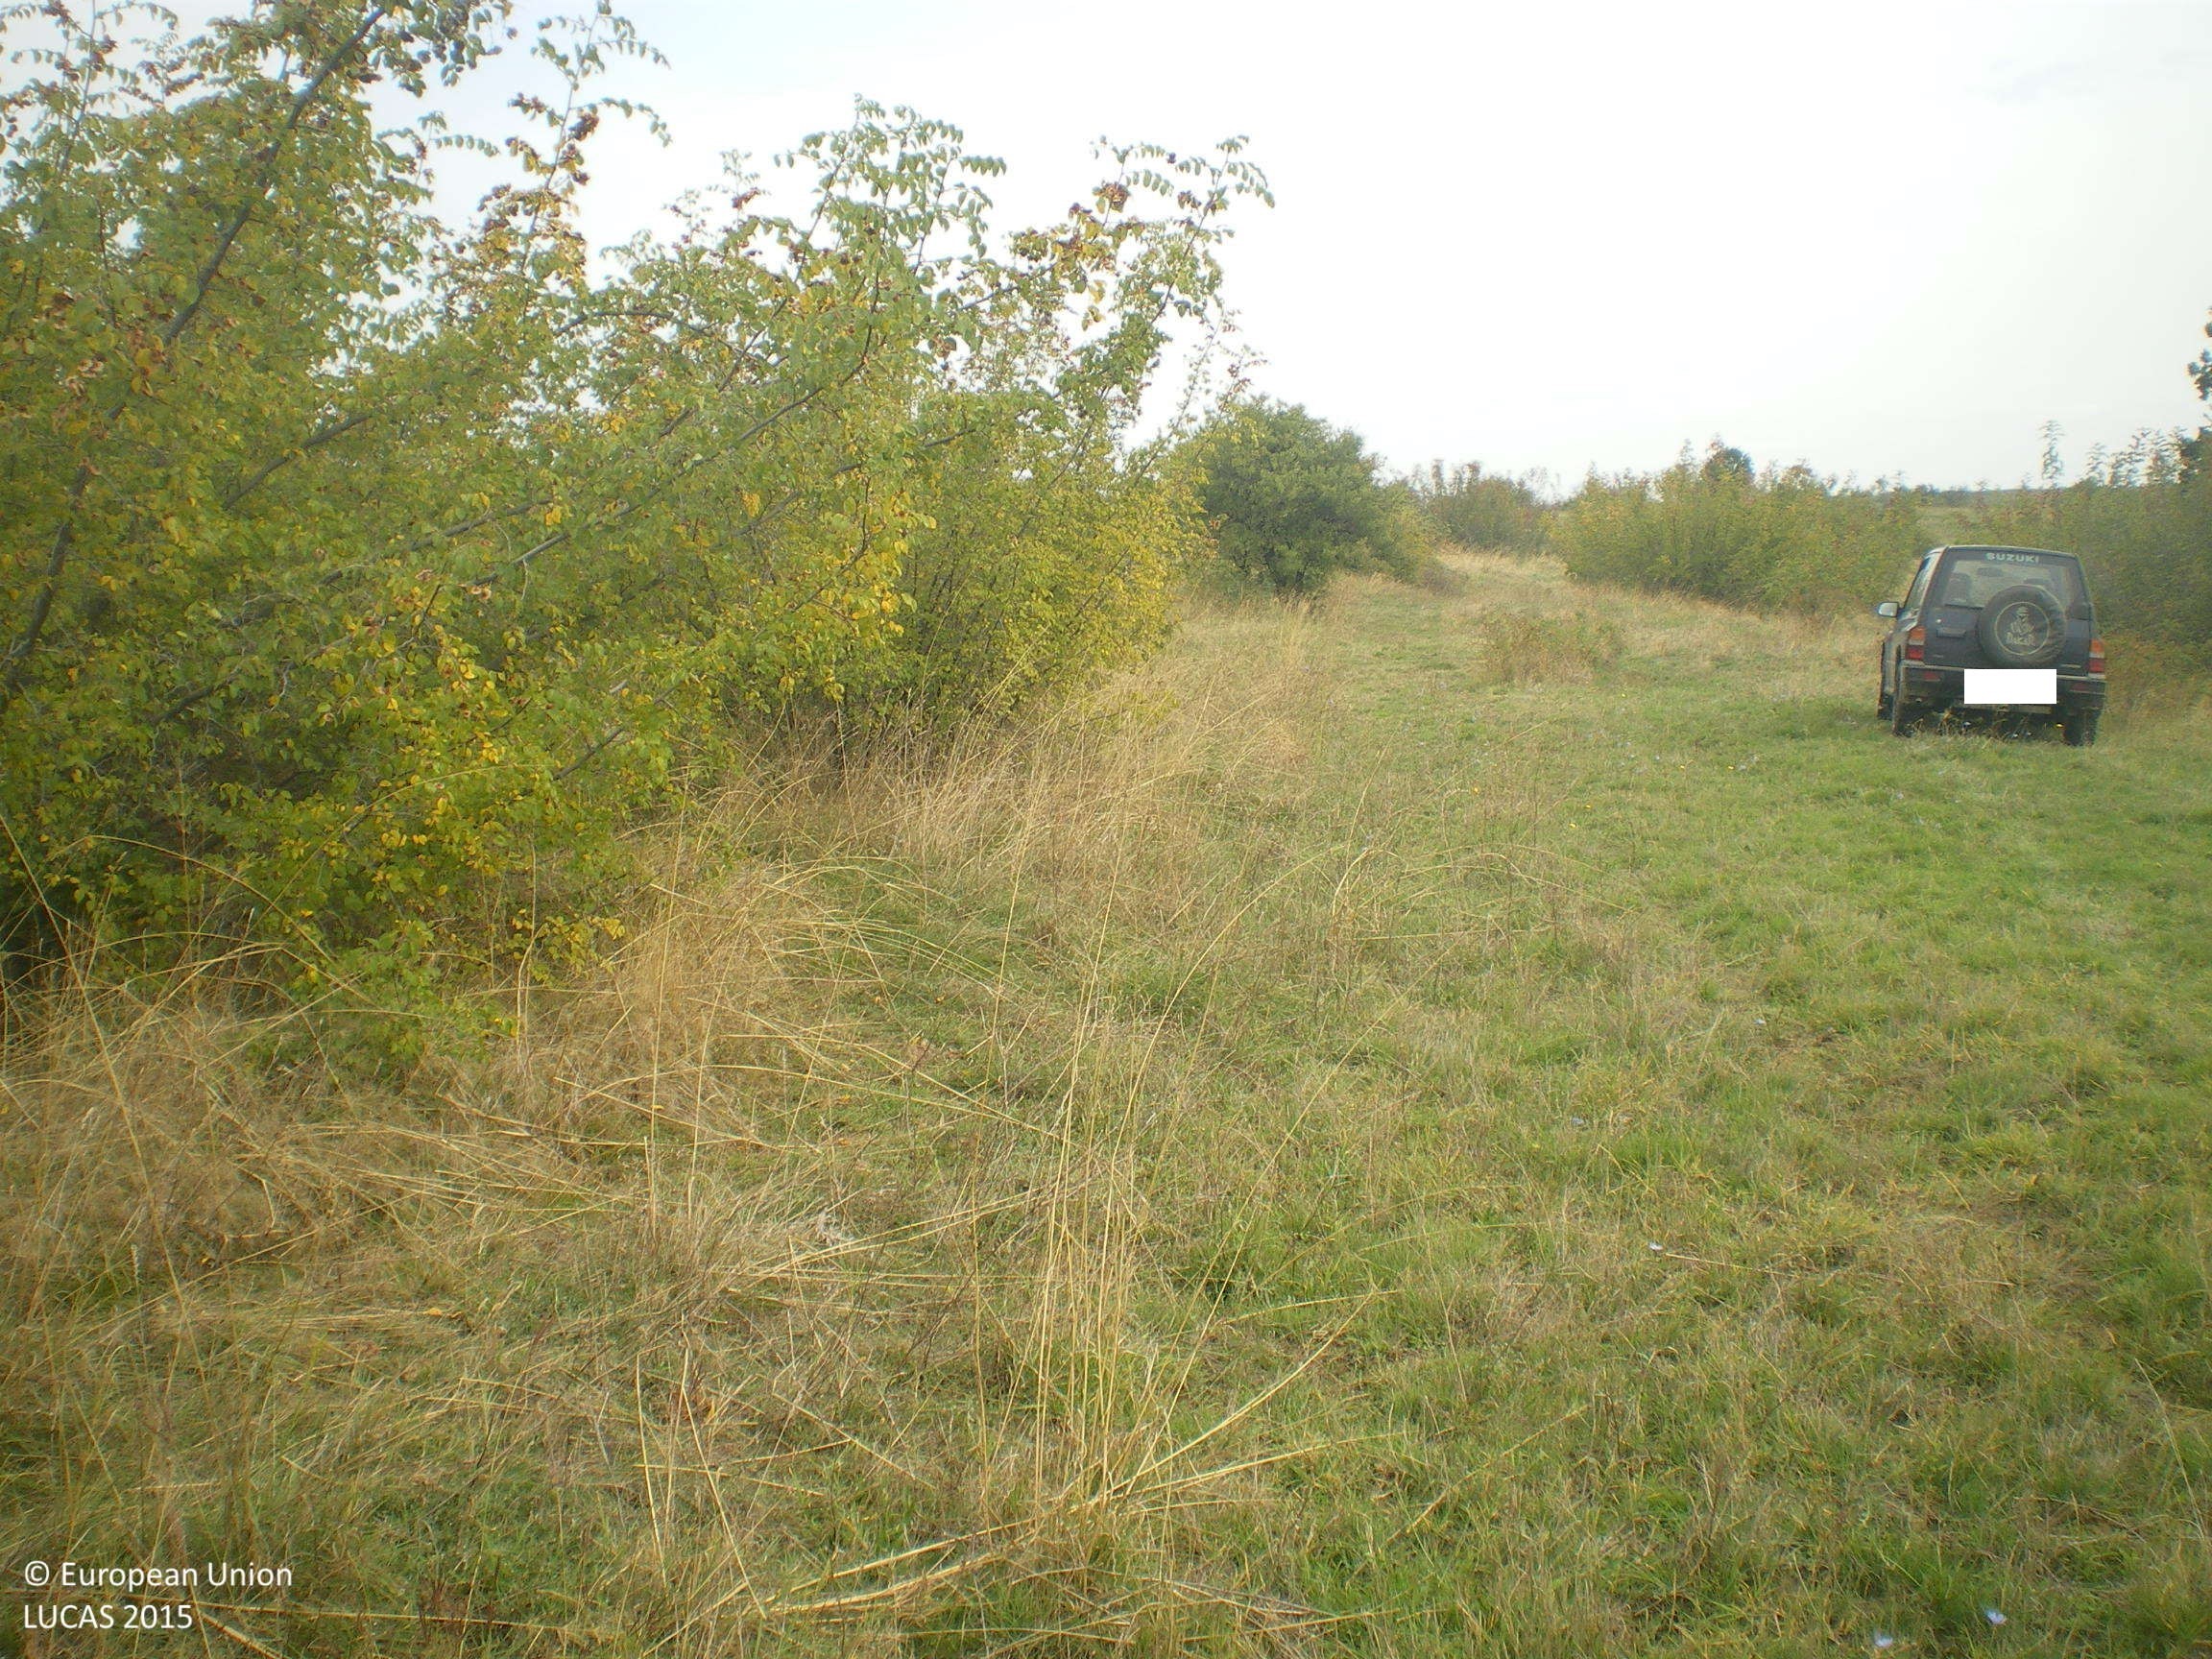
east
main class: Grassland
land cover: Grassland with sparse tree/shrub cover
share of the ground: > 75 %
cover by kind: herbaceous plants 90 %, broadleaved forest trees 5 %, shrubs 5 %
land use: Agriculture (excluding fallow land and kitchen gardens)
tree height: > 5 m
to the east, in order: Grassland with sparse tree/shrub cover
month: October
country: BG
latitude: 41.9317
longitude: 26.1774
